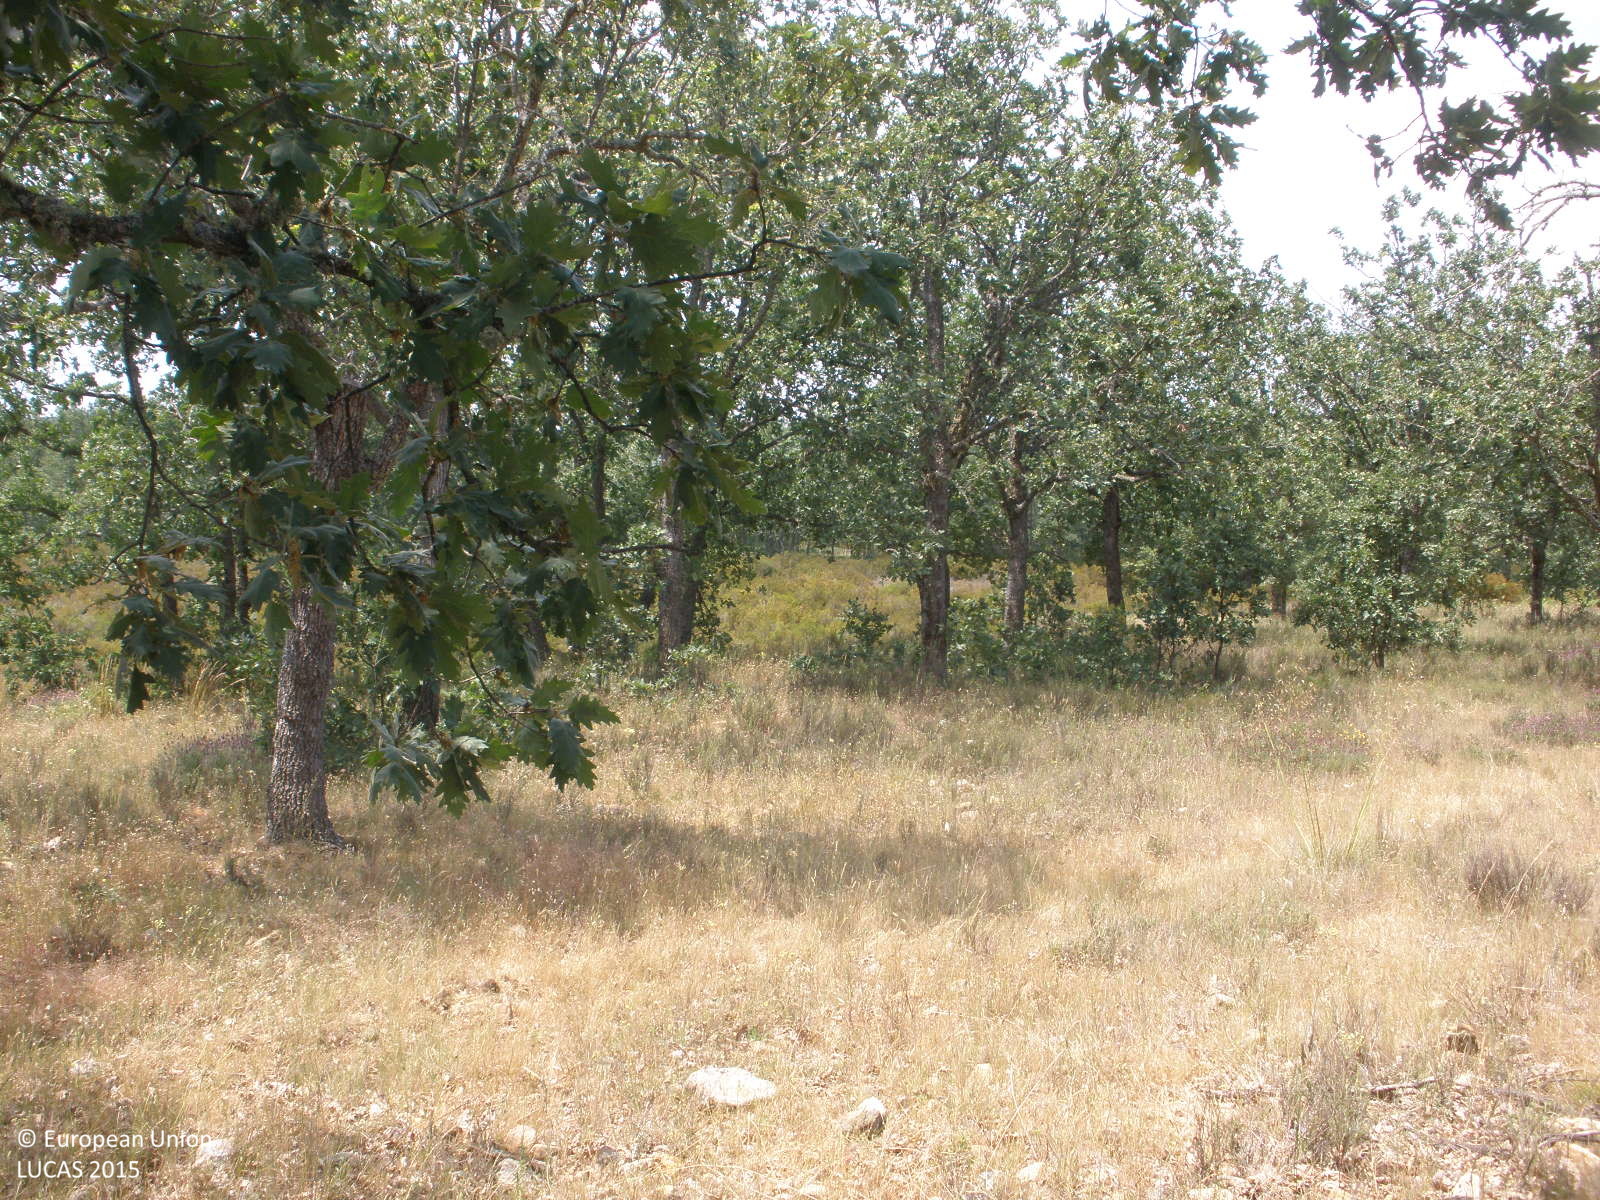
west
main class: Woodland
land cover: Broadleaved woodland
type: thermophilous deciduous forest
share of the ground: > 75 %
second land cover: Grassland without tree/shrub cover
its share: > 75 %
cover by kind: broadleaved forest trees 60 %, herbaceous plants 30 %, shrubs 10 %
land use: Forestry
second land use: Agriculture (excluding fallow land and kitchen gardens)
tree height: > 5 m
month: June
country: ES
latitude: 40.5863
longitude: -6.3066
